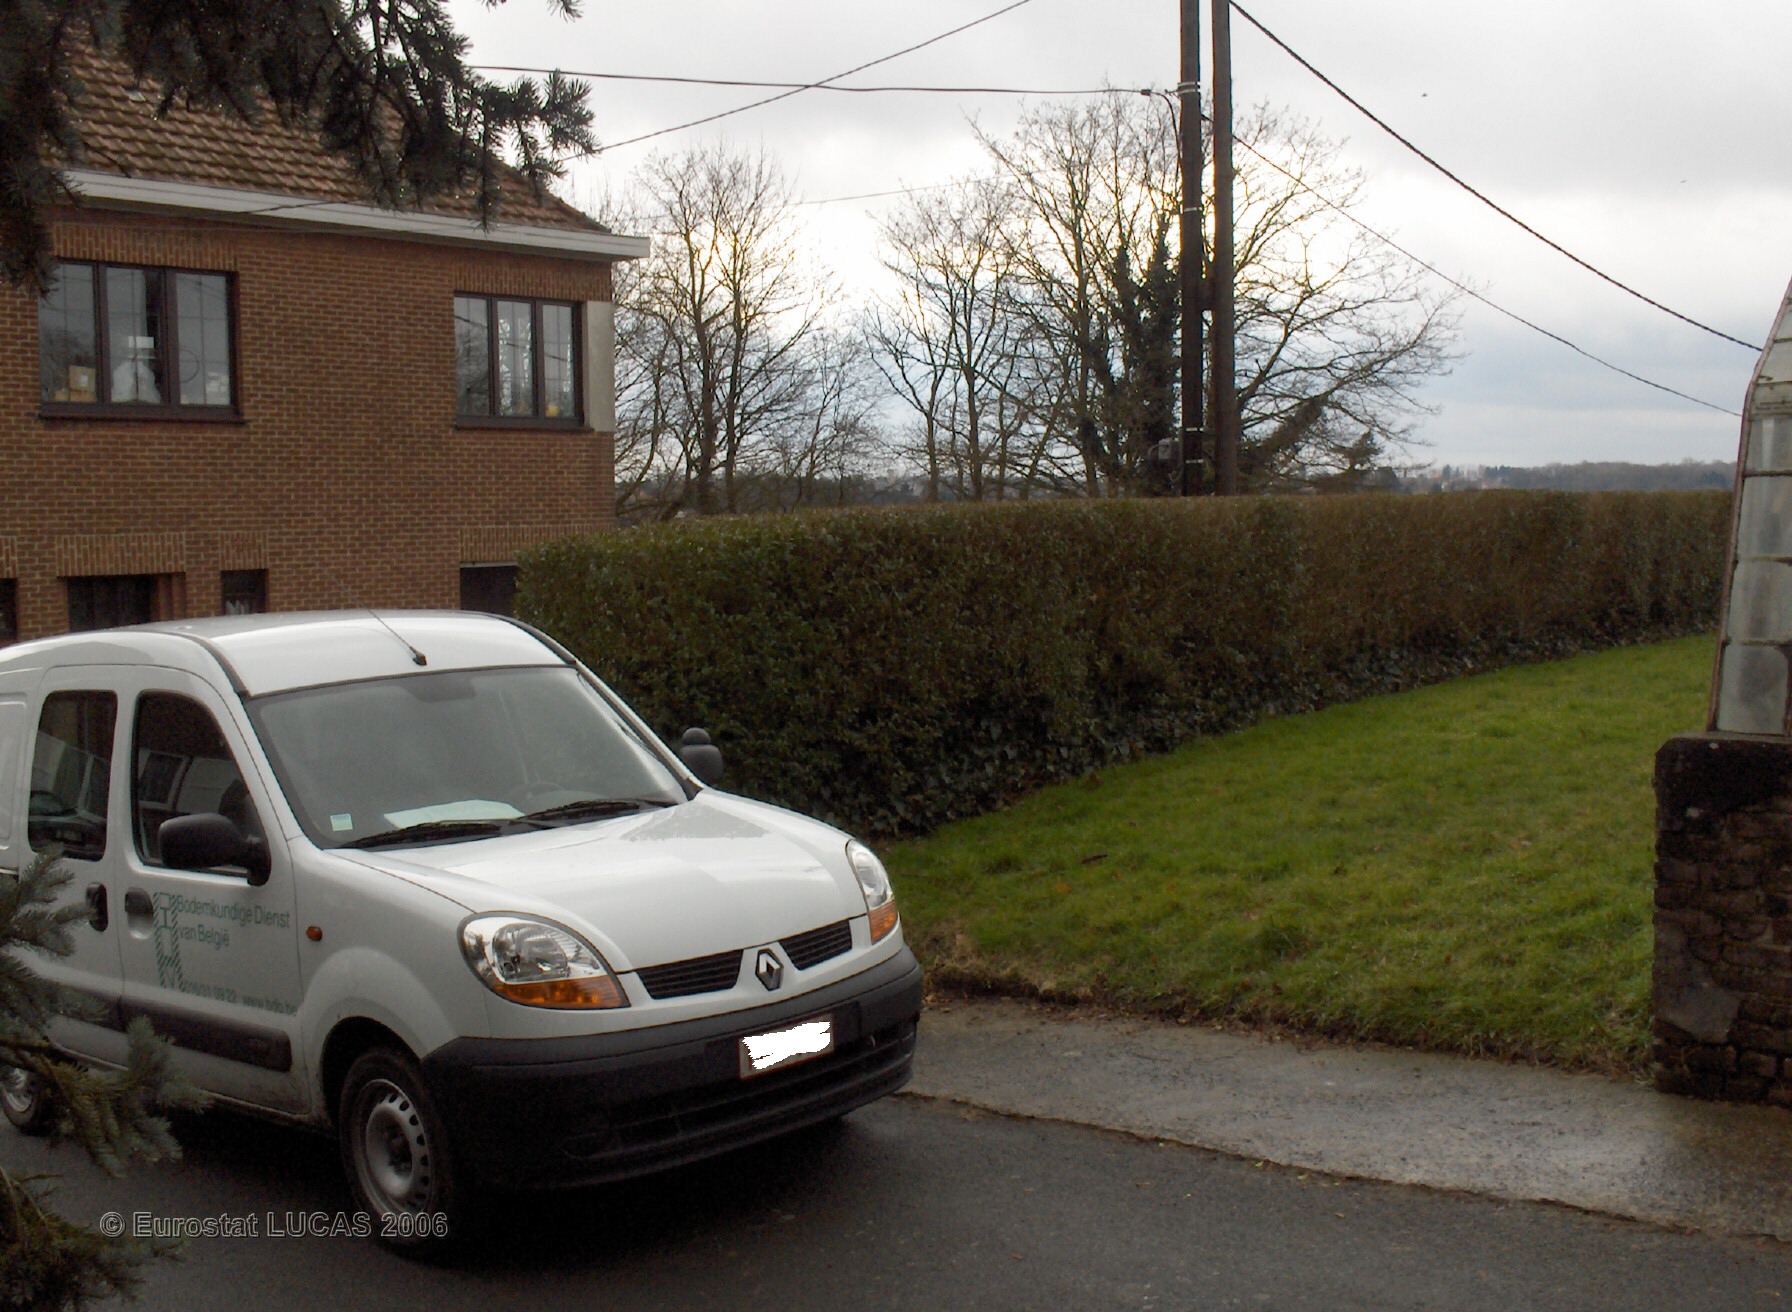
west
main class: Grassland
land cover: Grassland with sparse tree/shrub cover
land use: Residential
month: February
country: BE
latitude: 50.7742
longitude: 4.5363
